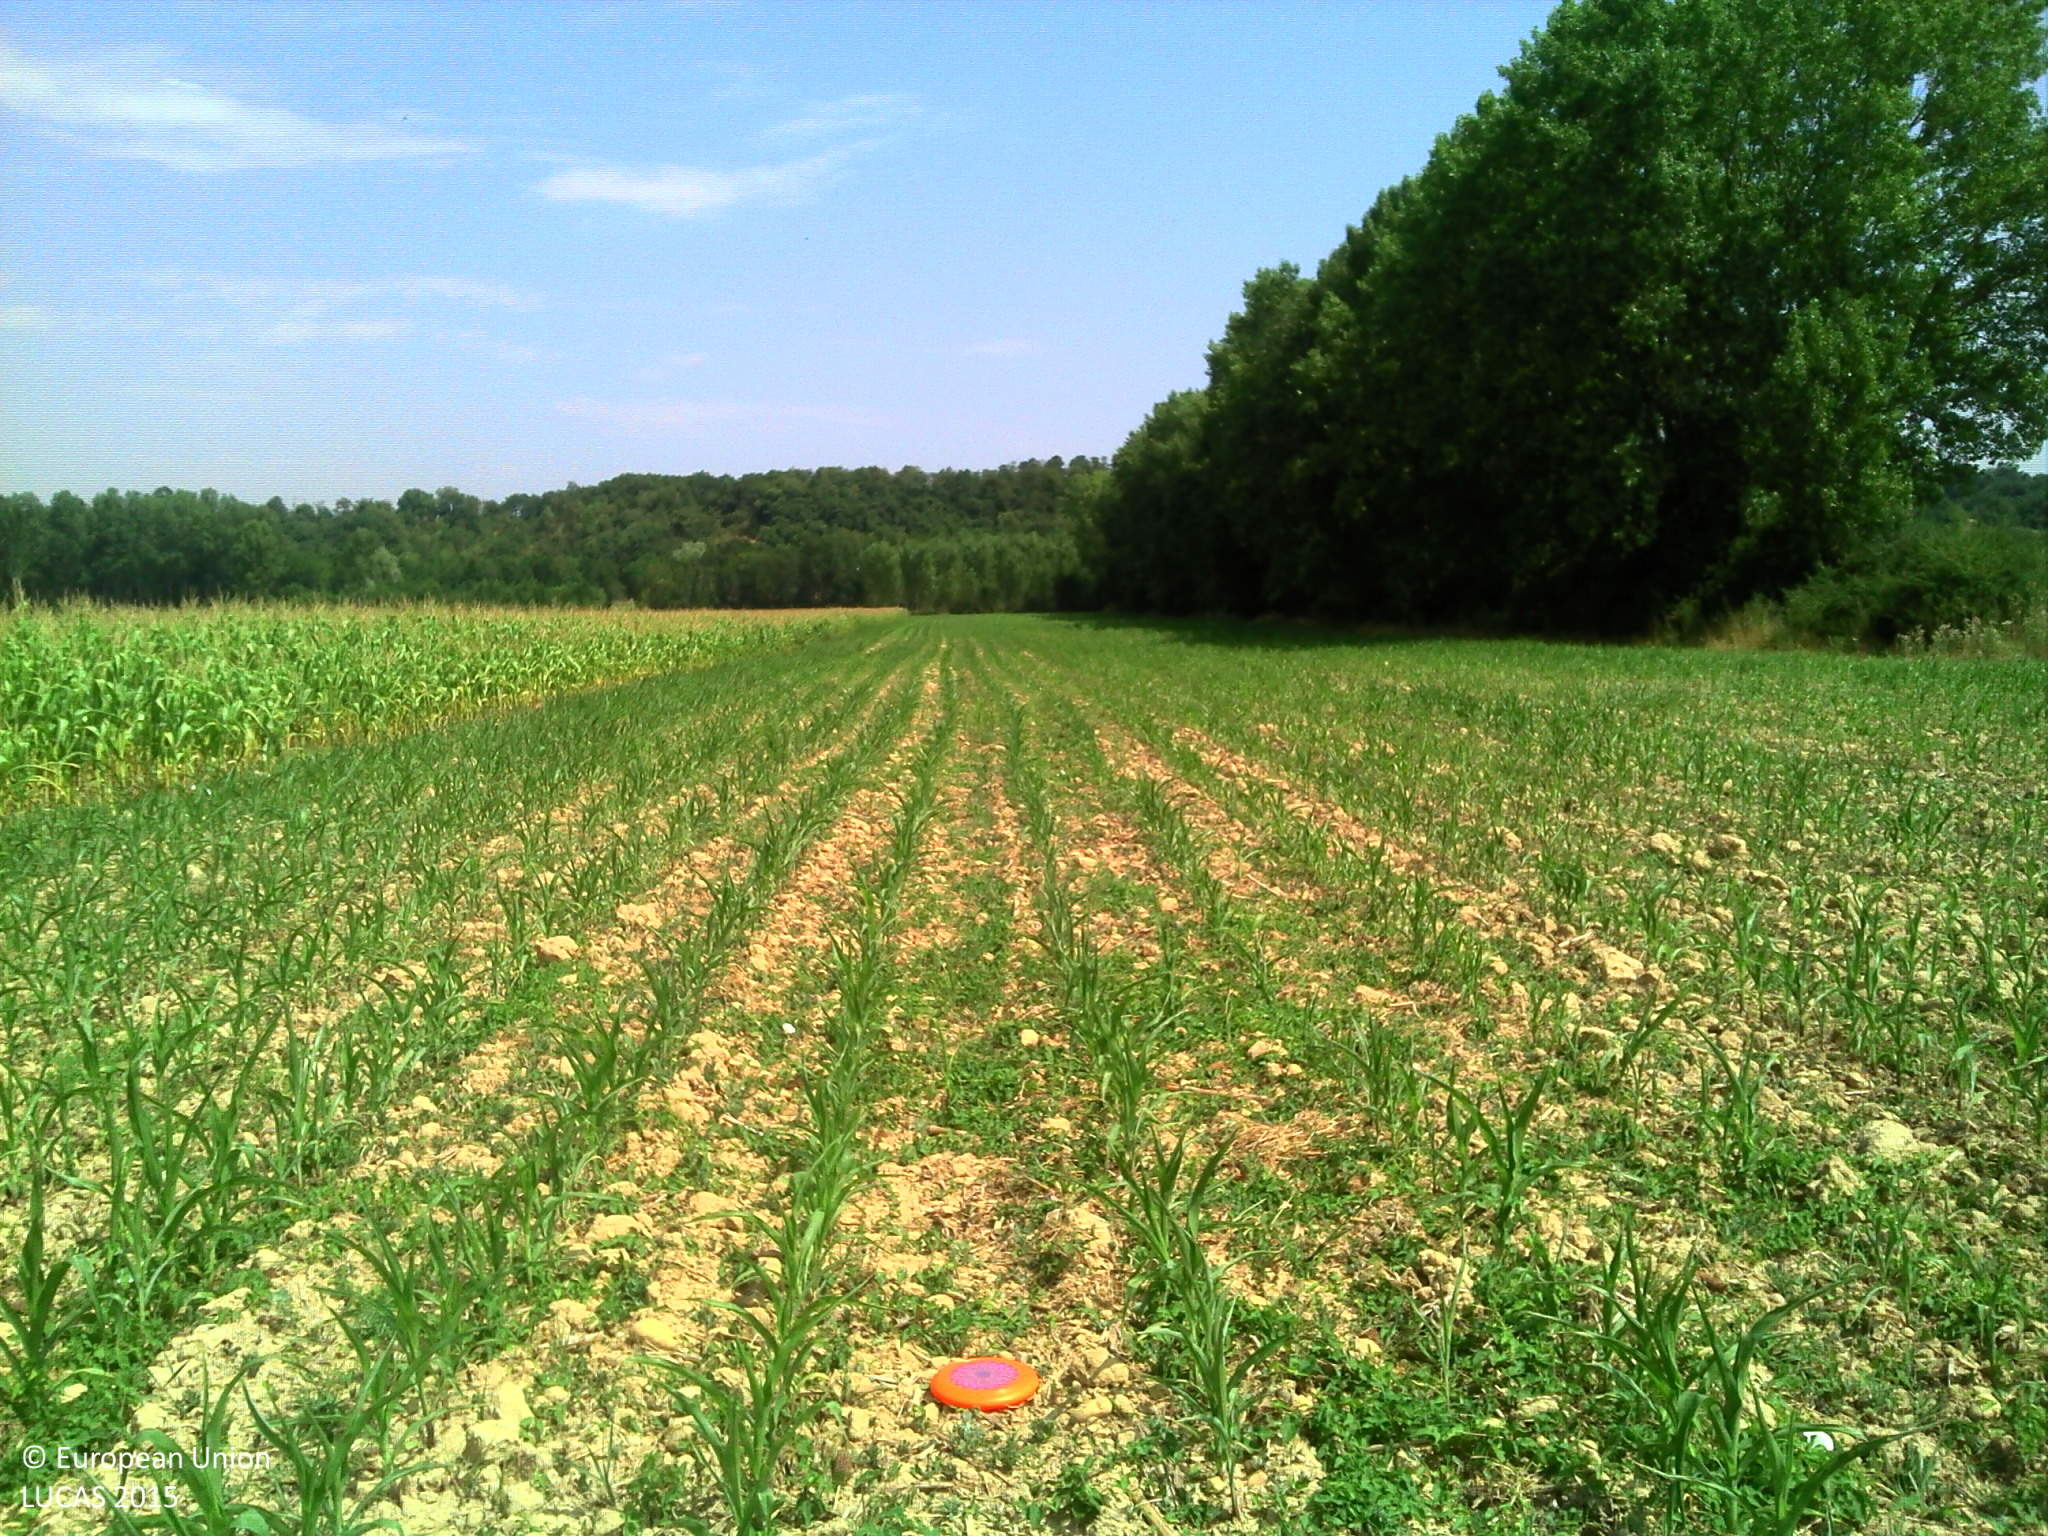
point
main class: Cropland
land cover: Maize
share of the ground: 50 - 75 %
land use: Agriculture (excluding fallow land and kitchen gardens)
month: July
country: FR
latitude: 45.3373
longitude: 5.1174
